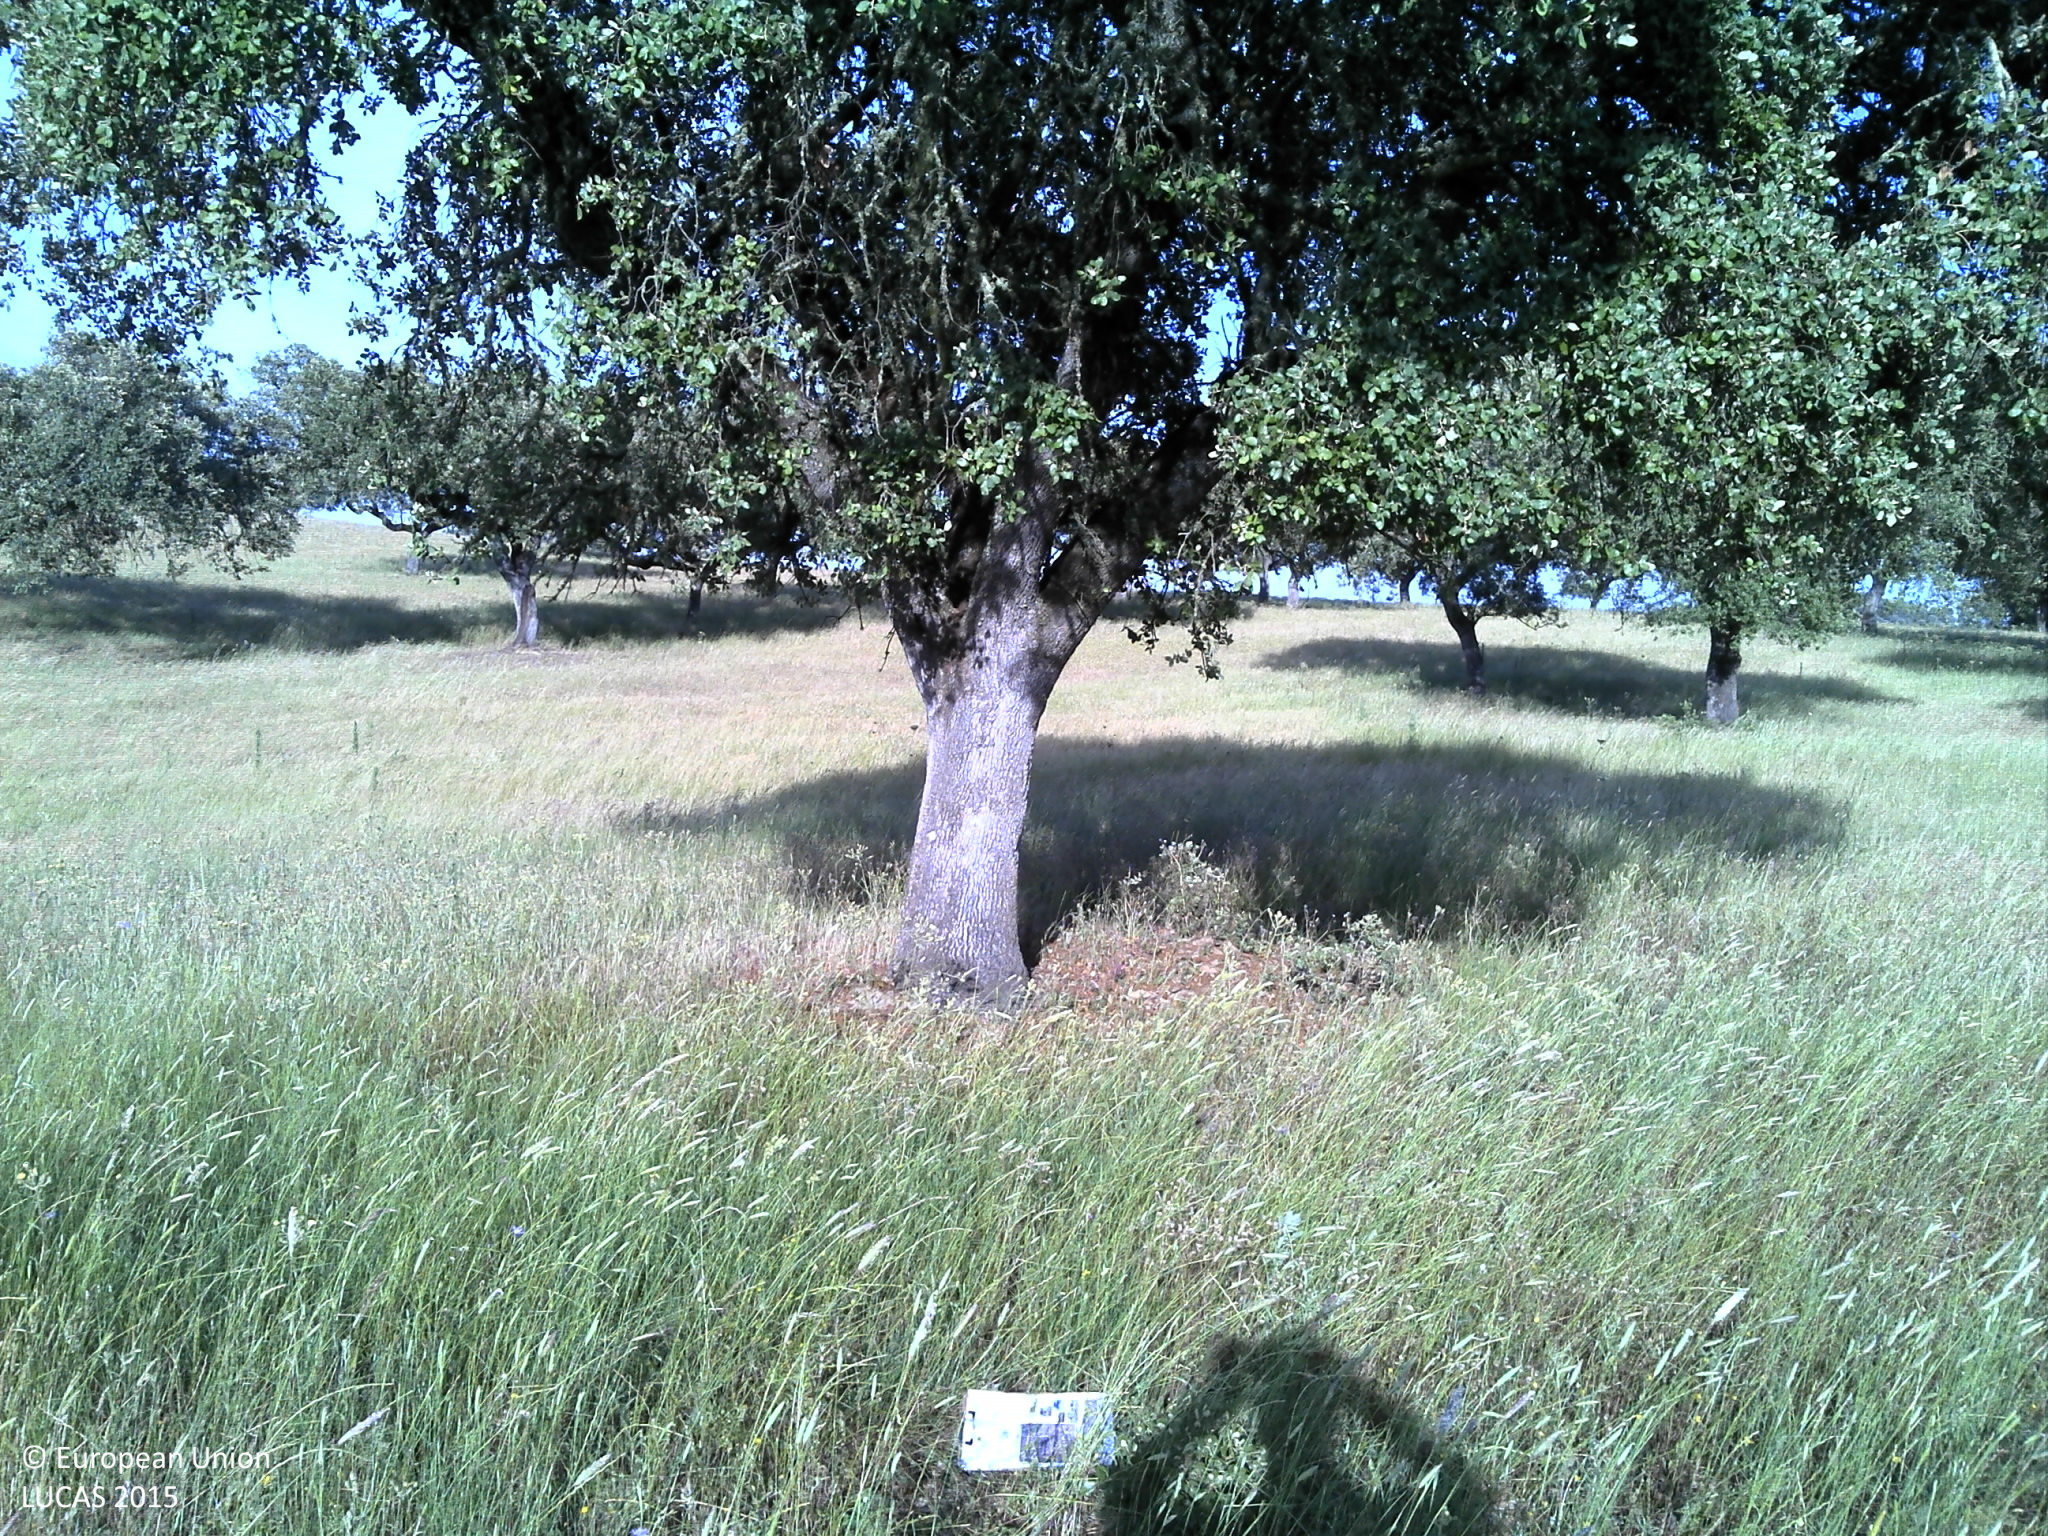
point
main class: Woodland
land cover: Broadleaved woodland
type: broadleaved evergreen forest
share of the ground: 10 - 25 %
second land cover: Grassland without tree/shrub cover
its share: 50 - 75 %
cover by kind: herbaceous plants 75 %, broadleaved forest trees 15 %, unconsolidated bare surface 10 %
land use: Forestry
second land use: Agriculture (excluding fallow land and kitchen gardens)
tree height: > 5 m
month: May
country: PT
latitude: 38.9664
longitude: -7.9484
